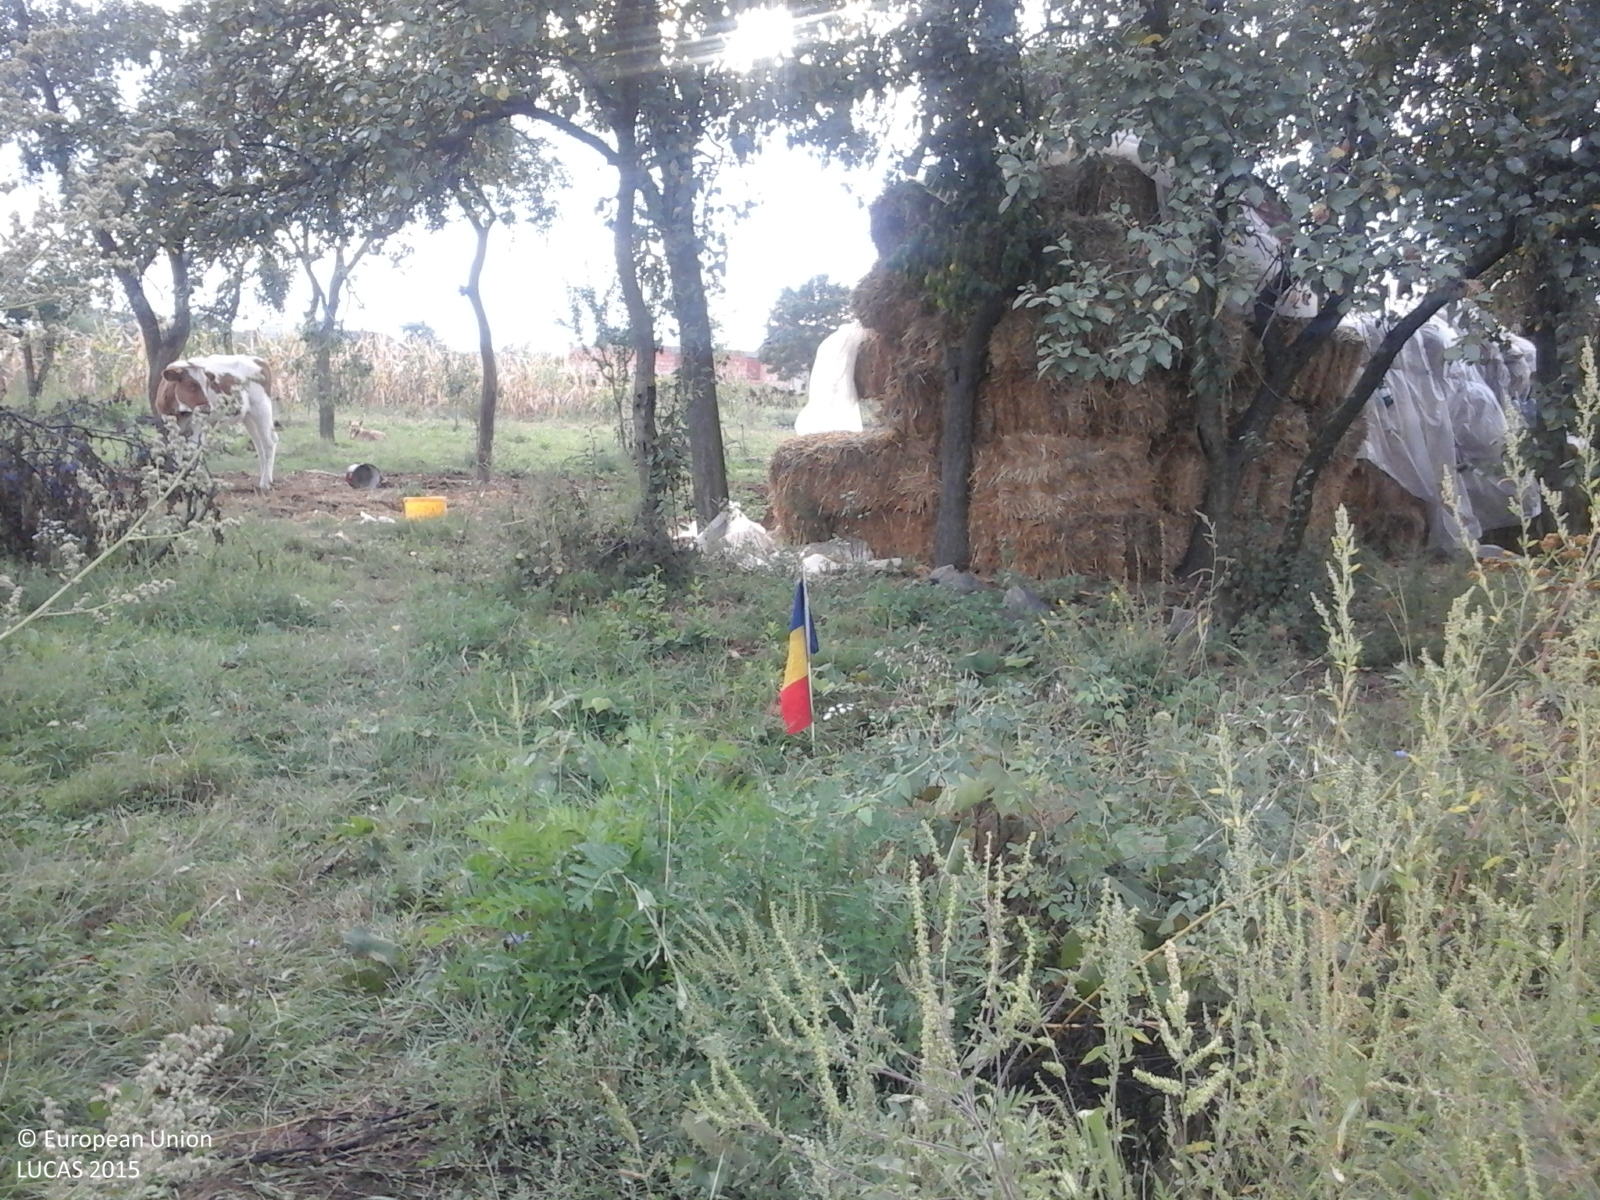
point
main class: Cropland
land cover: Other fruit trees and berries
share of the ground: > 75 %
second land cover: Grassland without tree/shrub cover
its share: > 75 %
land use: Agriculture (excluding fallow land and kitchen gardens)
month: September
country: RO
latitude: 47.4498
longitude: 22.5374
